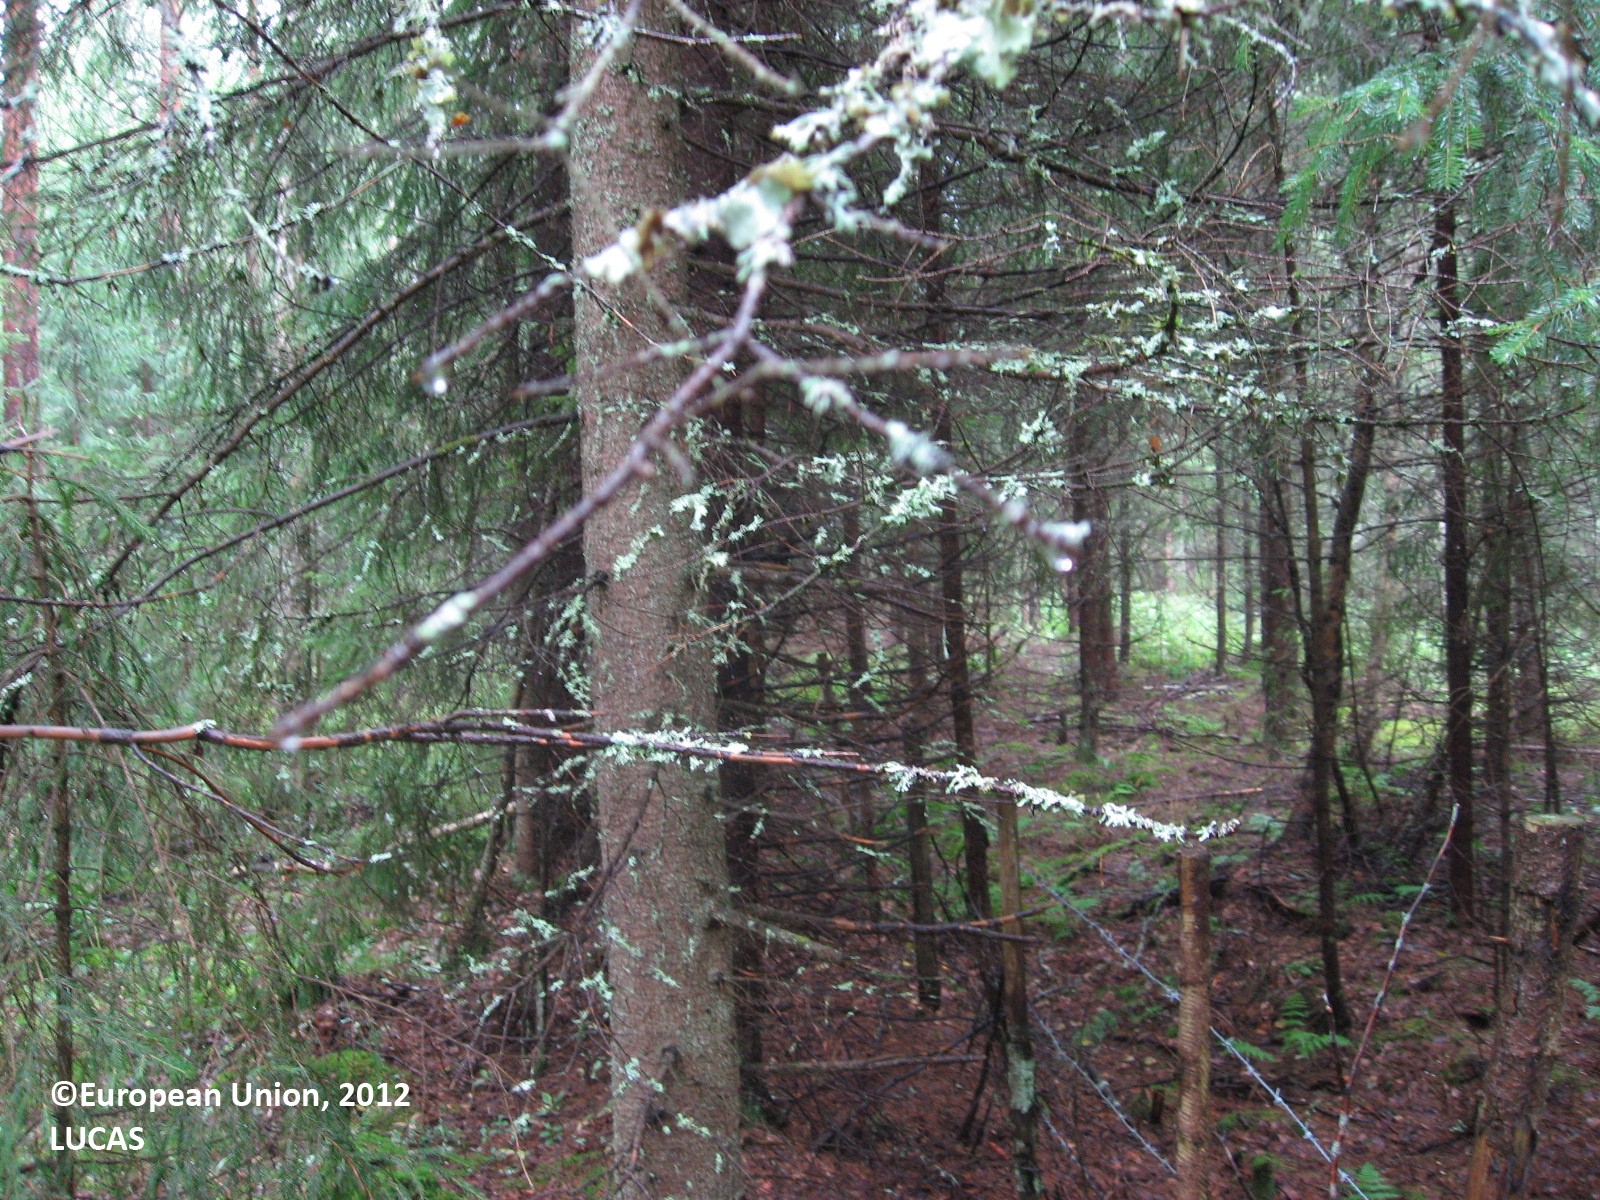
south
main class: Woodland
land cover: Spruce dominated mixed woodland
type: boreal forest
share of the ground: > 75 %
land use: Forestry
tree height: > 5 m
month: August
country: FI
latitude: 61.0692
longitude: 24.7659
